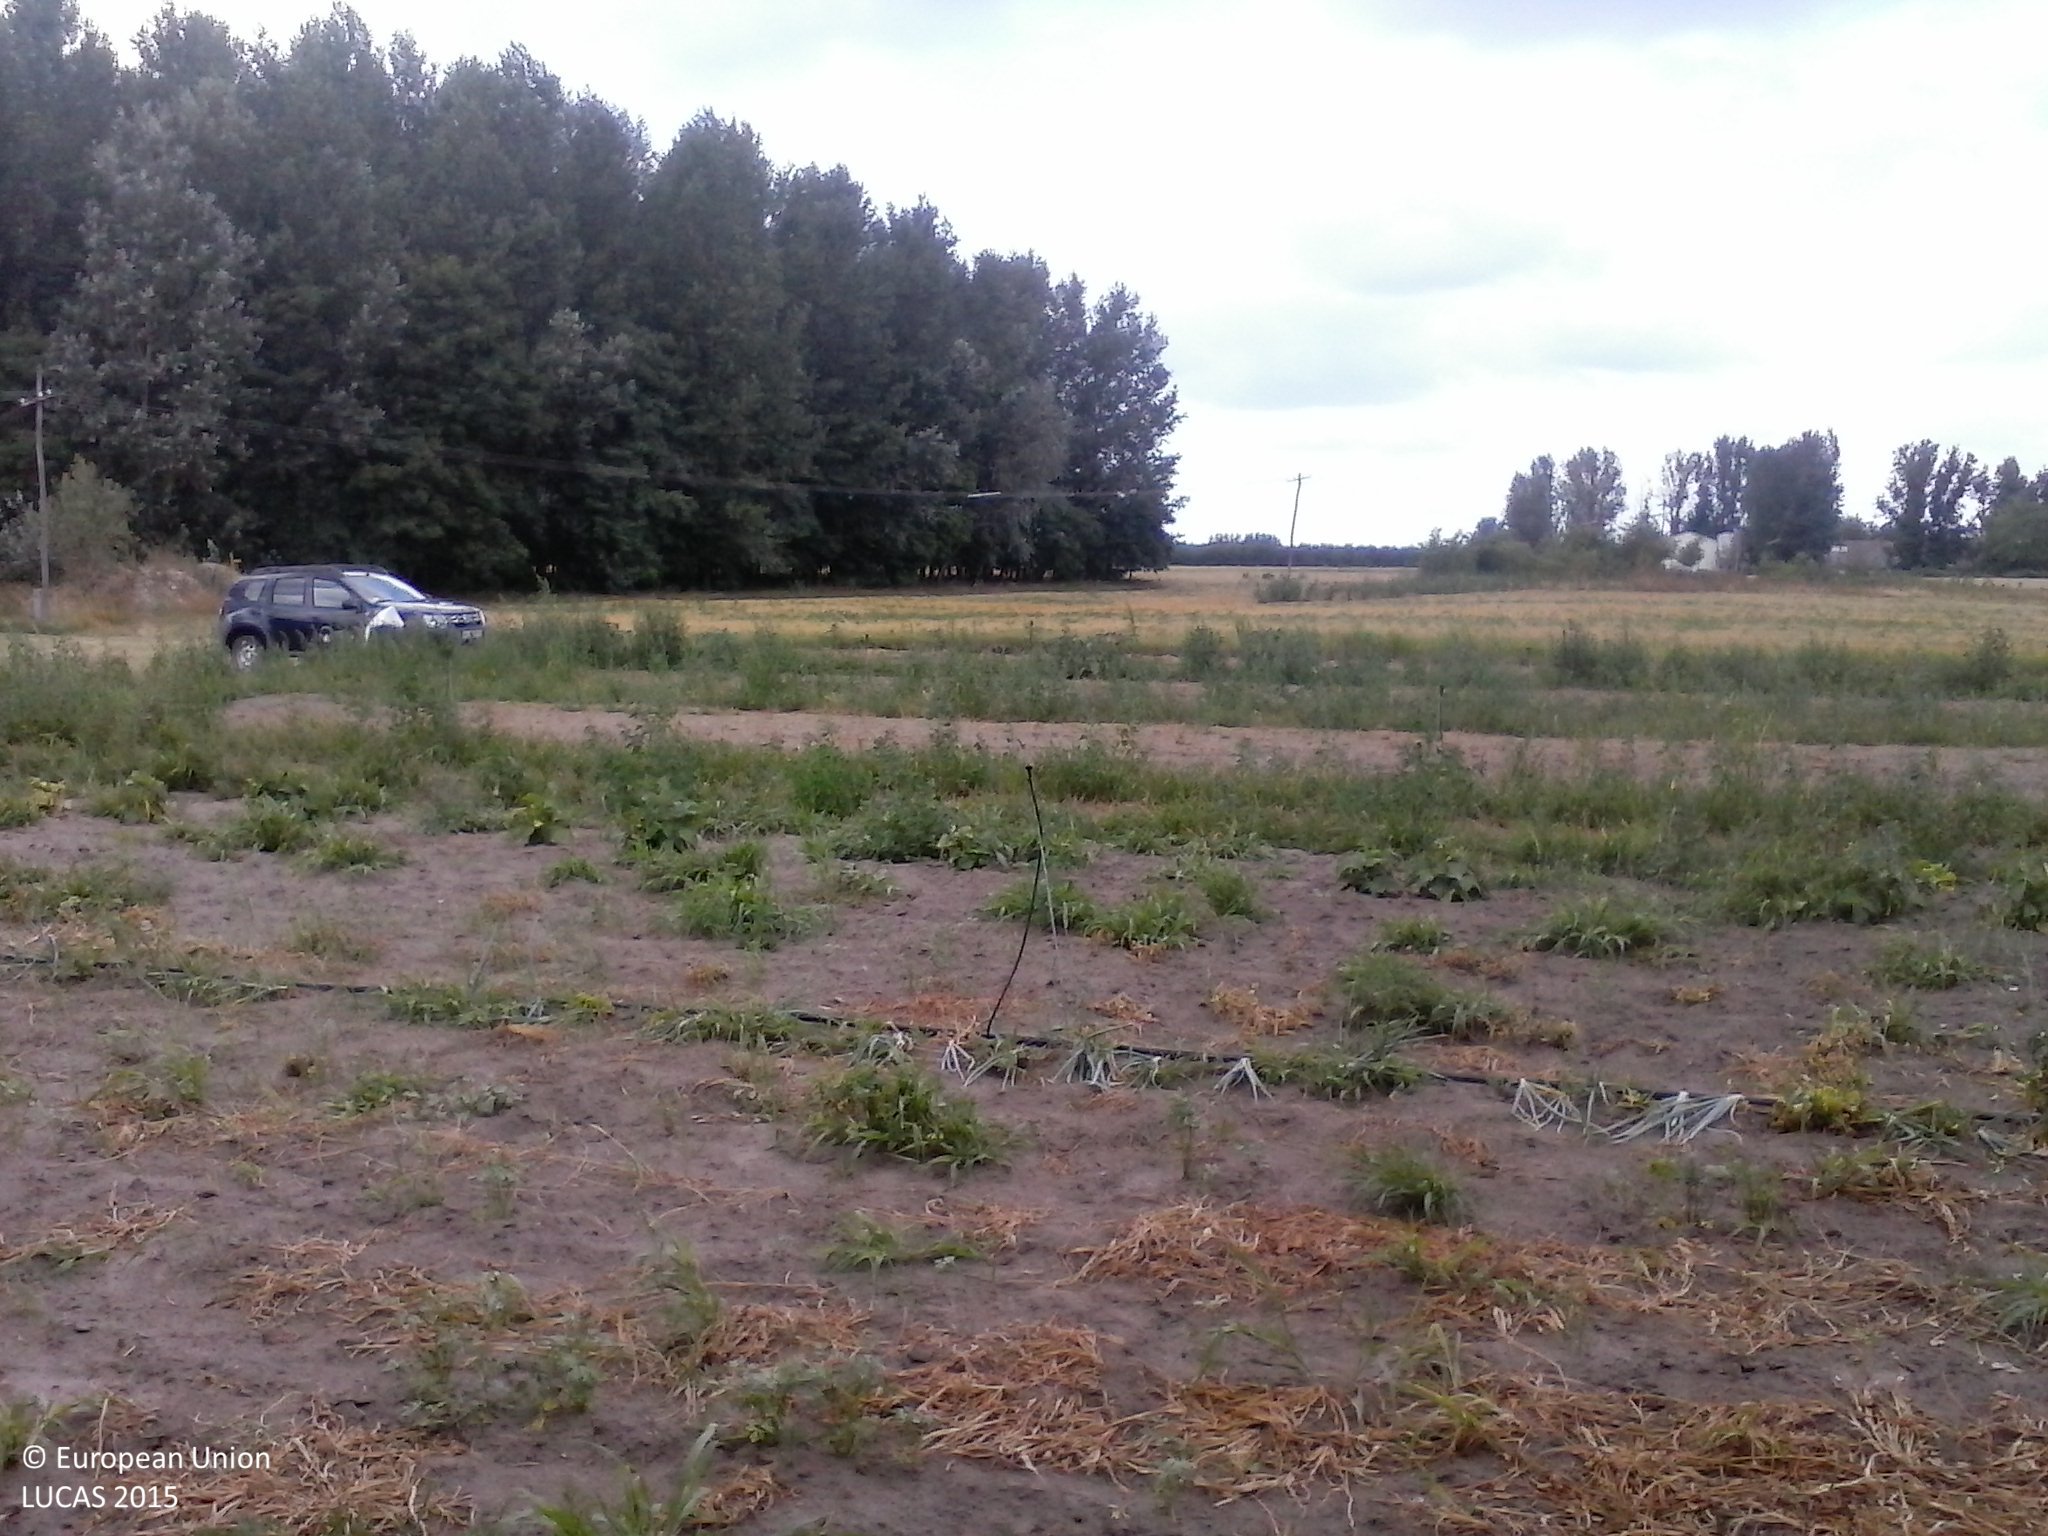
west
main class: Cropland
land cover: Maize
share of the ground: 10 - 25 %
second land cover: Spontaneously vegetated surfaces
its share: > 75 %
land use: Kitchen garden
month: July
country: HU
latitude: 46.5611
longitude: 19.7118
